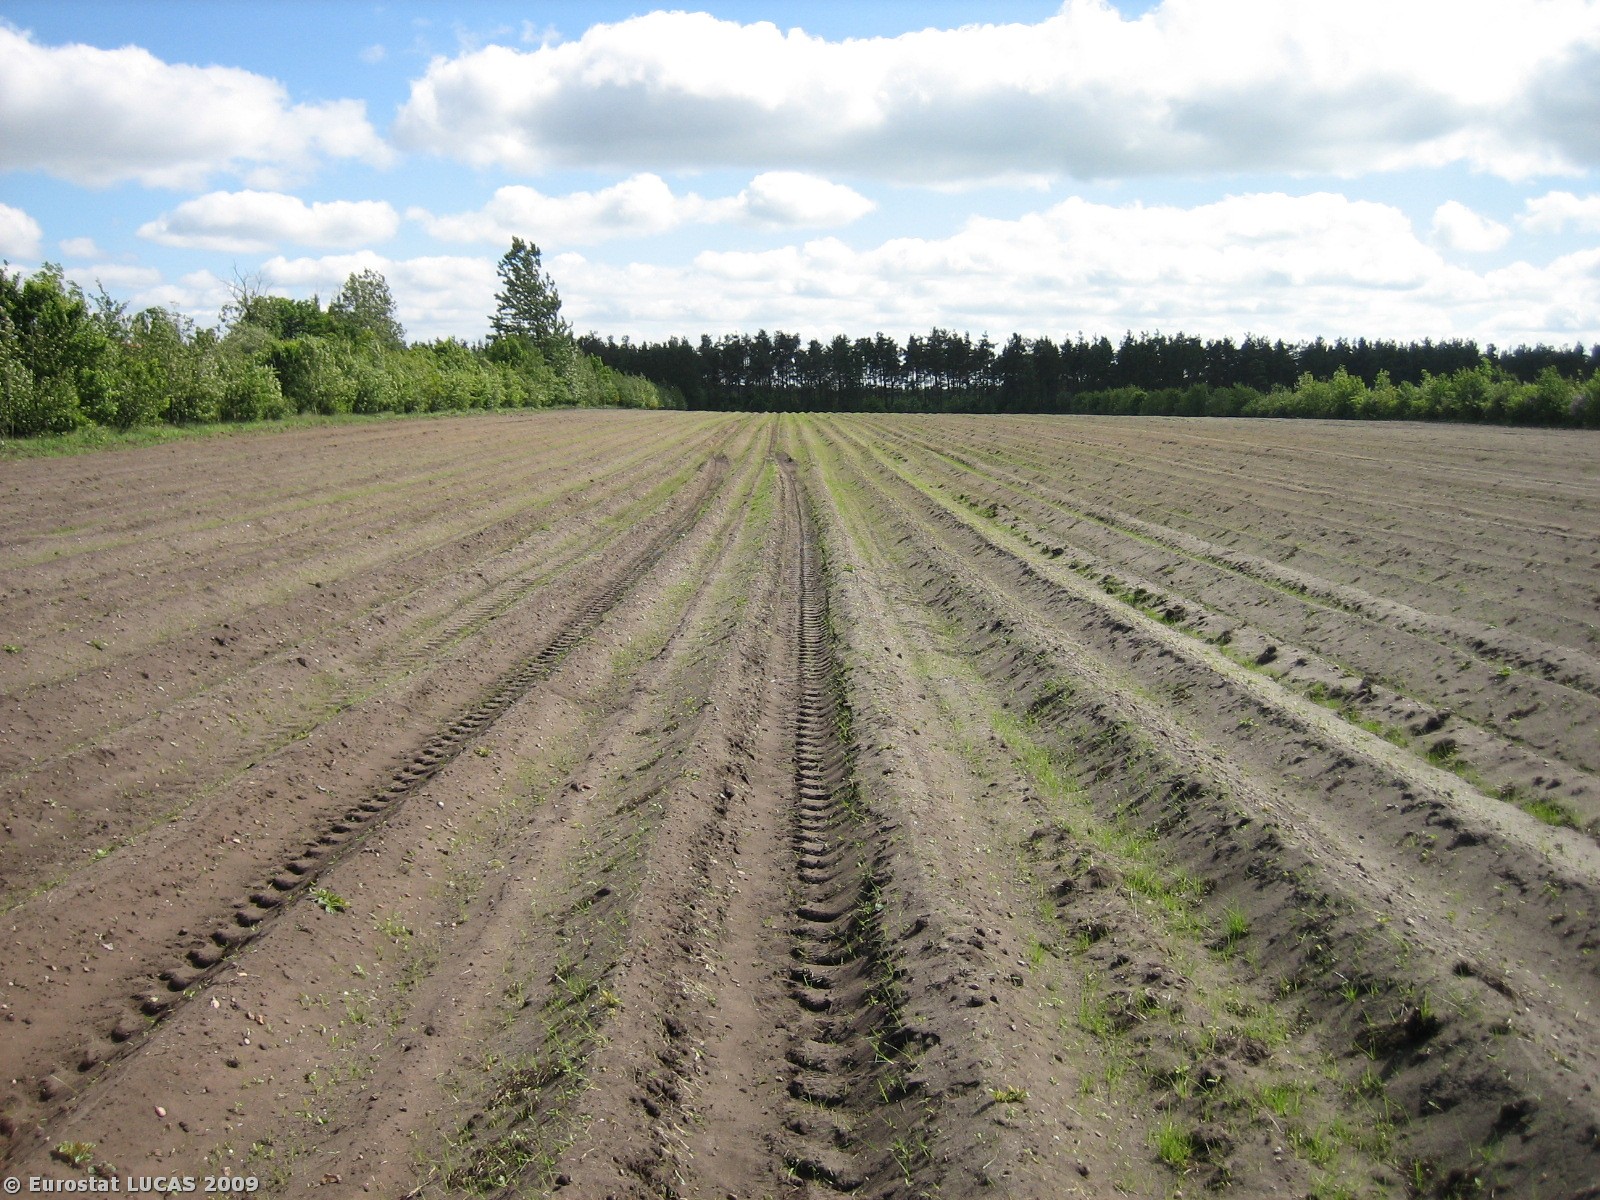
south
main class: Cropland
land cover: Potatoes
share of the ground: < 10 %
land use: Agriculture (excluding fallow land and kitchen gardens)
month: May
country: DK
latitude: 56.0040
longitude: 8.9908
